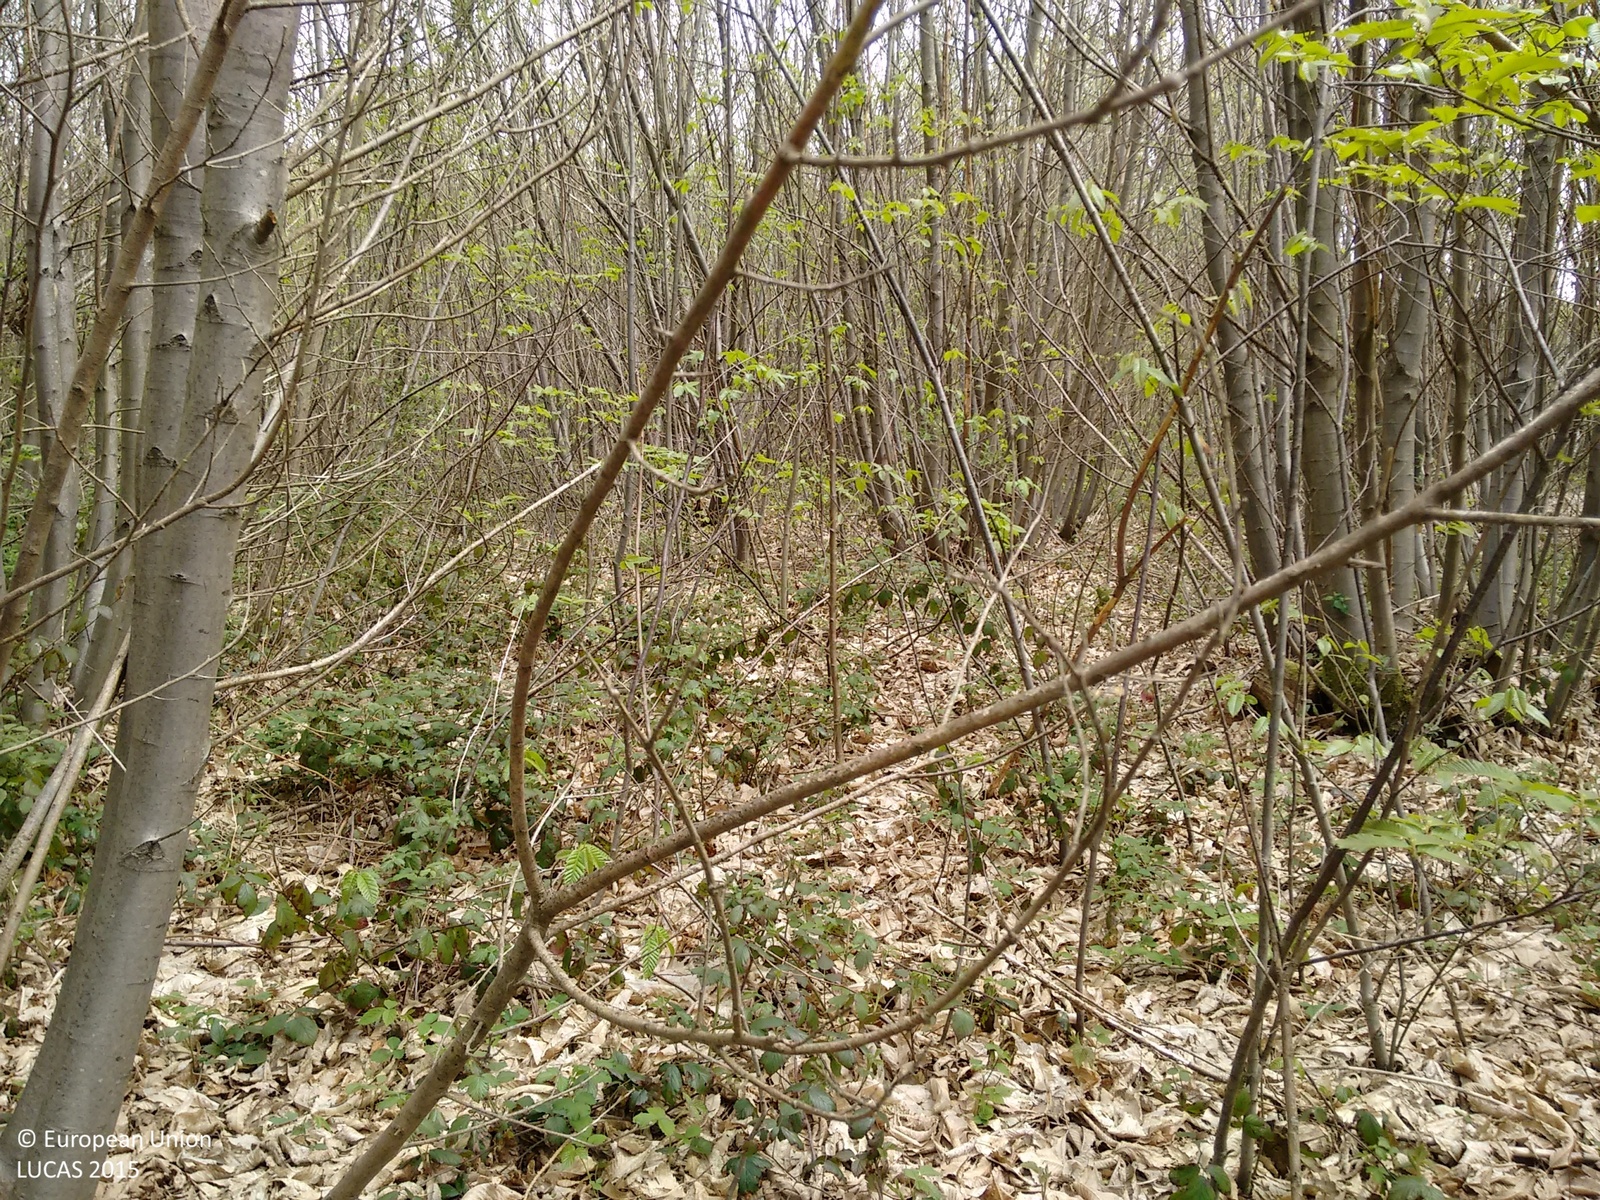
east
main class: Woodland
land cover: Broadleaved woodland
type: mesophytic deciduous forest
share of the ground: > 75 %
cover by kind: broadleaved forest trees 100 %
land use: Forestry
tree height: > 5 m
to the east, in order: Broadleaved woodland; Tracks; Broadleaved woodland; Artificial constructions in urban areas
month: May
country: GB
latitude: 51.2272
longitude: 0.6224
